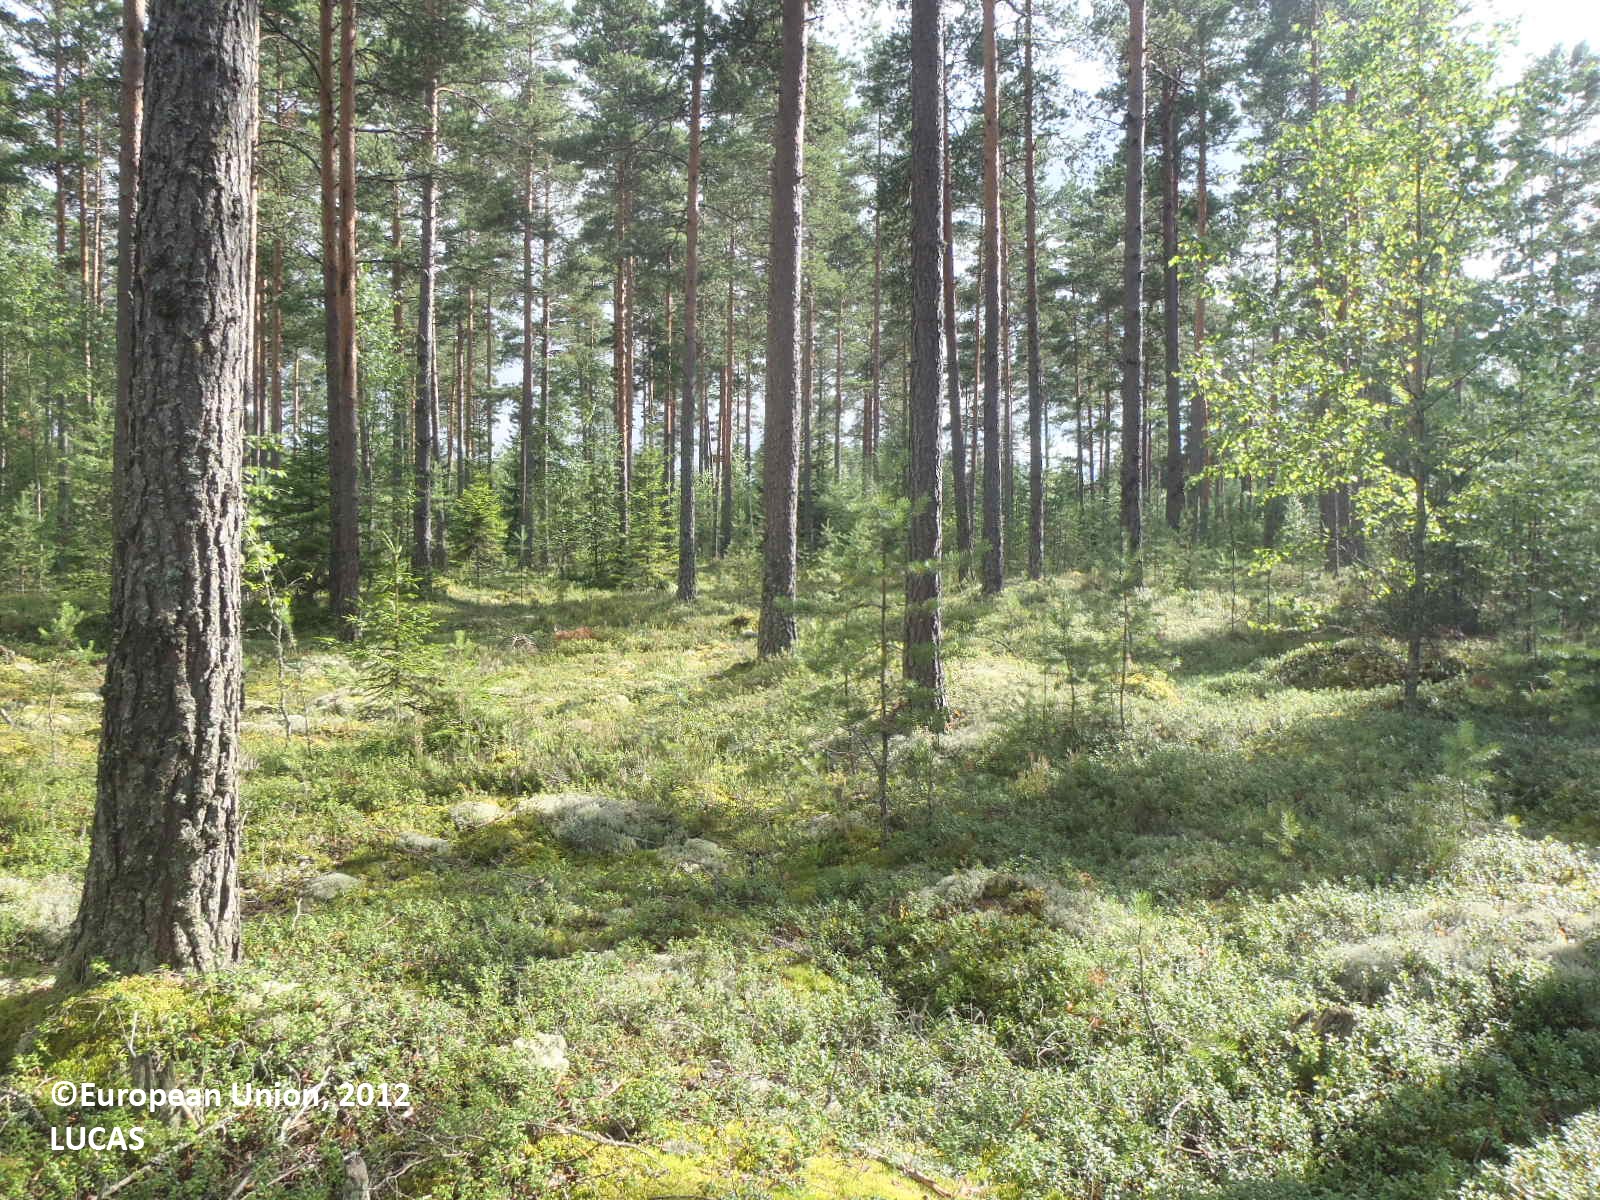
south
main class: Woodland
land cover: Pine dominated coniferous woodland
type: boreal forest
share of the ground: 50 - 75 %
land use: Forestry
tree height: > 5 m
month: July
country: FI
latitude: 60.8166
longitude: 21.7694
